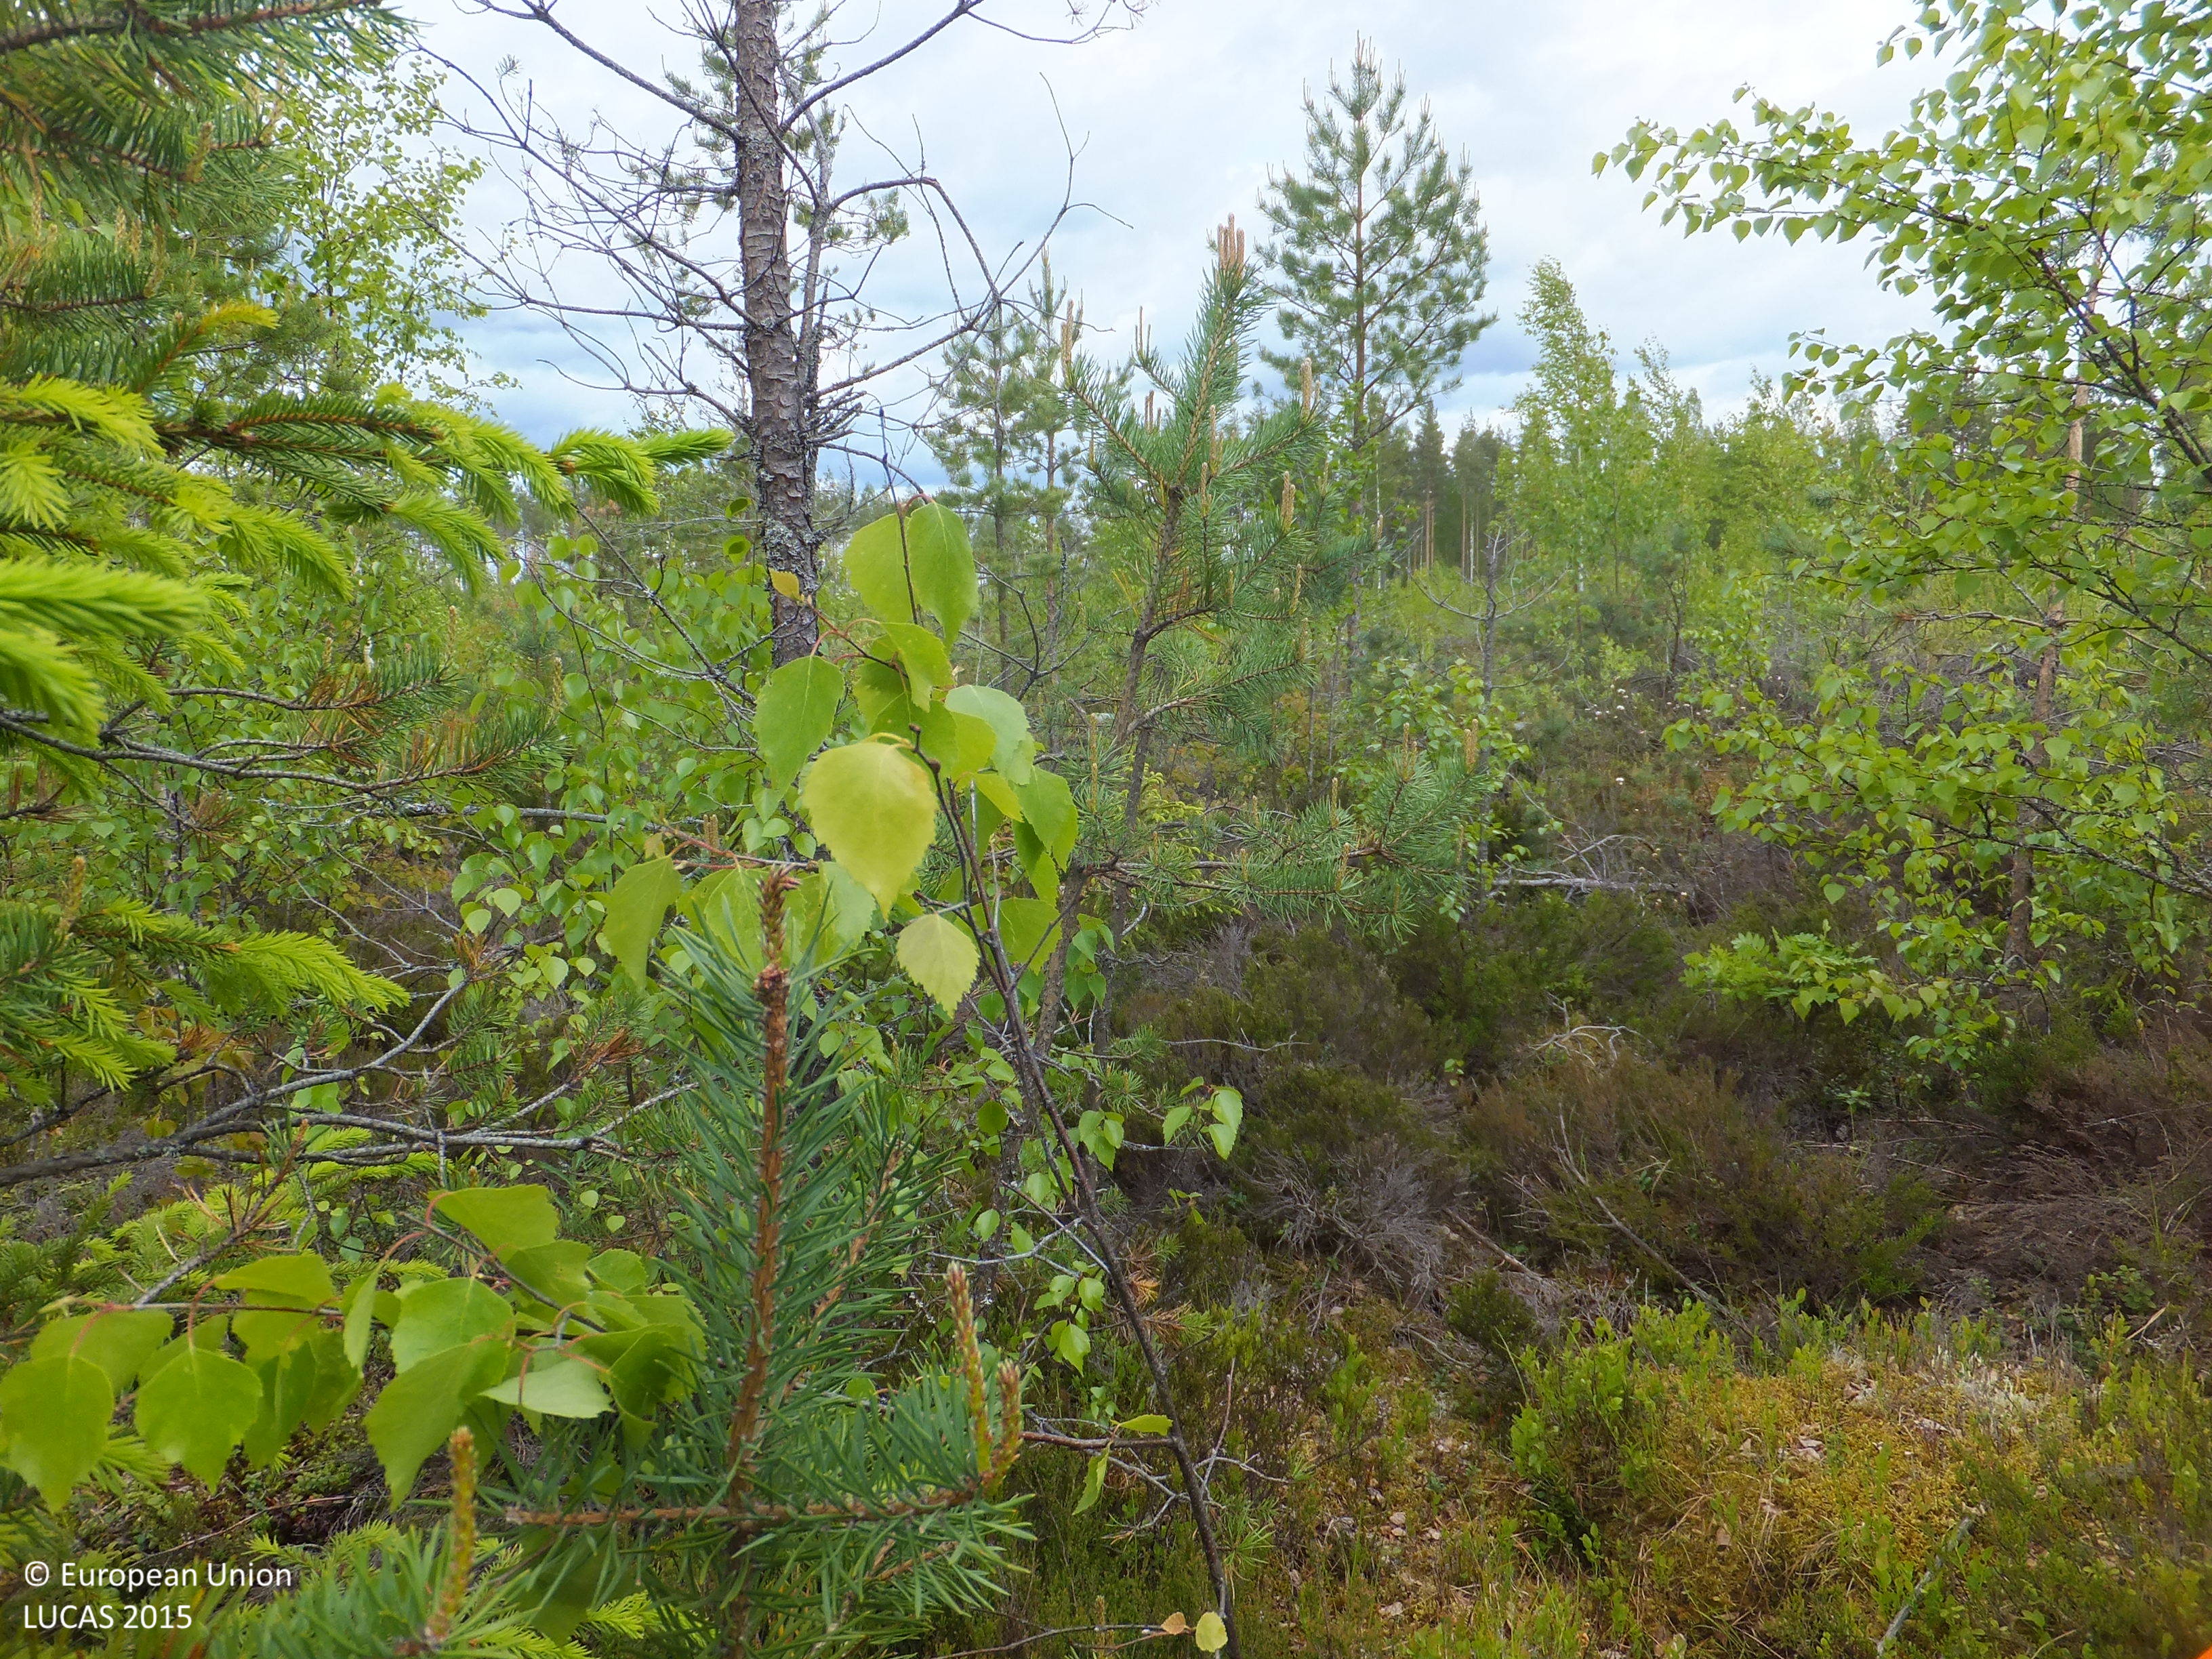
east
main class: Woodland
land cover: Pine dominated mixed woodland
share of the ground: 50 - 75 %
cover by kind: coniferous forest trees 30 %, broadleaved forest trees 30 %, shrubs 30 %, herbaceous plants 10 %
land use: Forestry
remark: Clear cut
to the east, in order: Pine dominated mixed woodland; Ditches and canals; Shrubland with sparse tree cover; Lines of trees; Ditches and canals; Lines of trees; Shrubland with sparse tree cover; Ditches and canals; Tracks; Ditches and canals; Pine dominated mixed woodland; Tracks; Pine dominated mixed woodland; Ditches and canals; Shrubland without tree cover; Ditches and canals; Shrubland without tree cover; Pine dominated mixed woodland; Shrubland with sparse tree cover
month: June
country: FI
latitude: 63.6871
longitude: 24.5361
